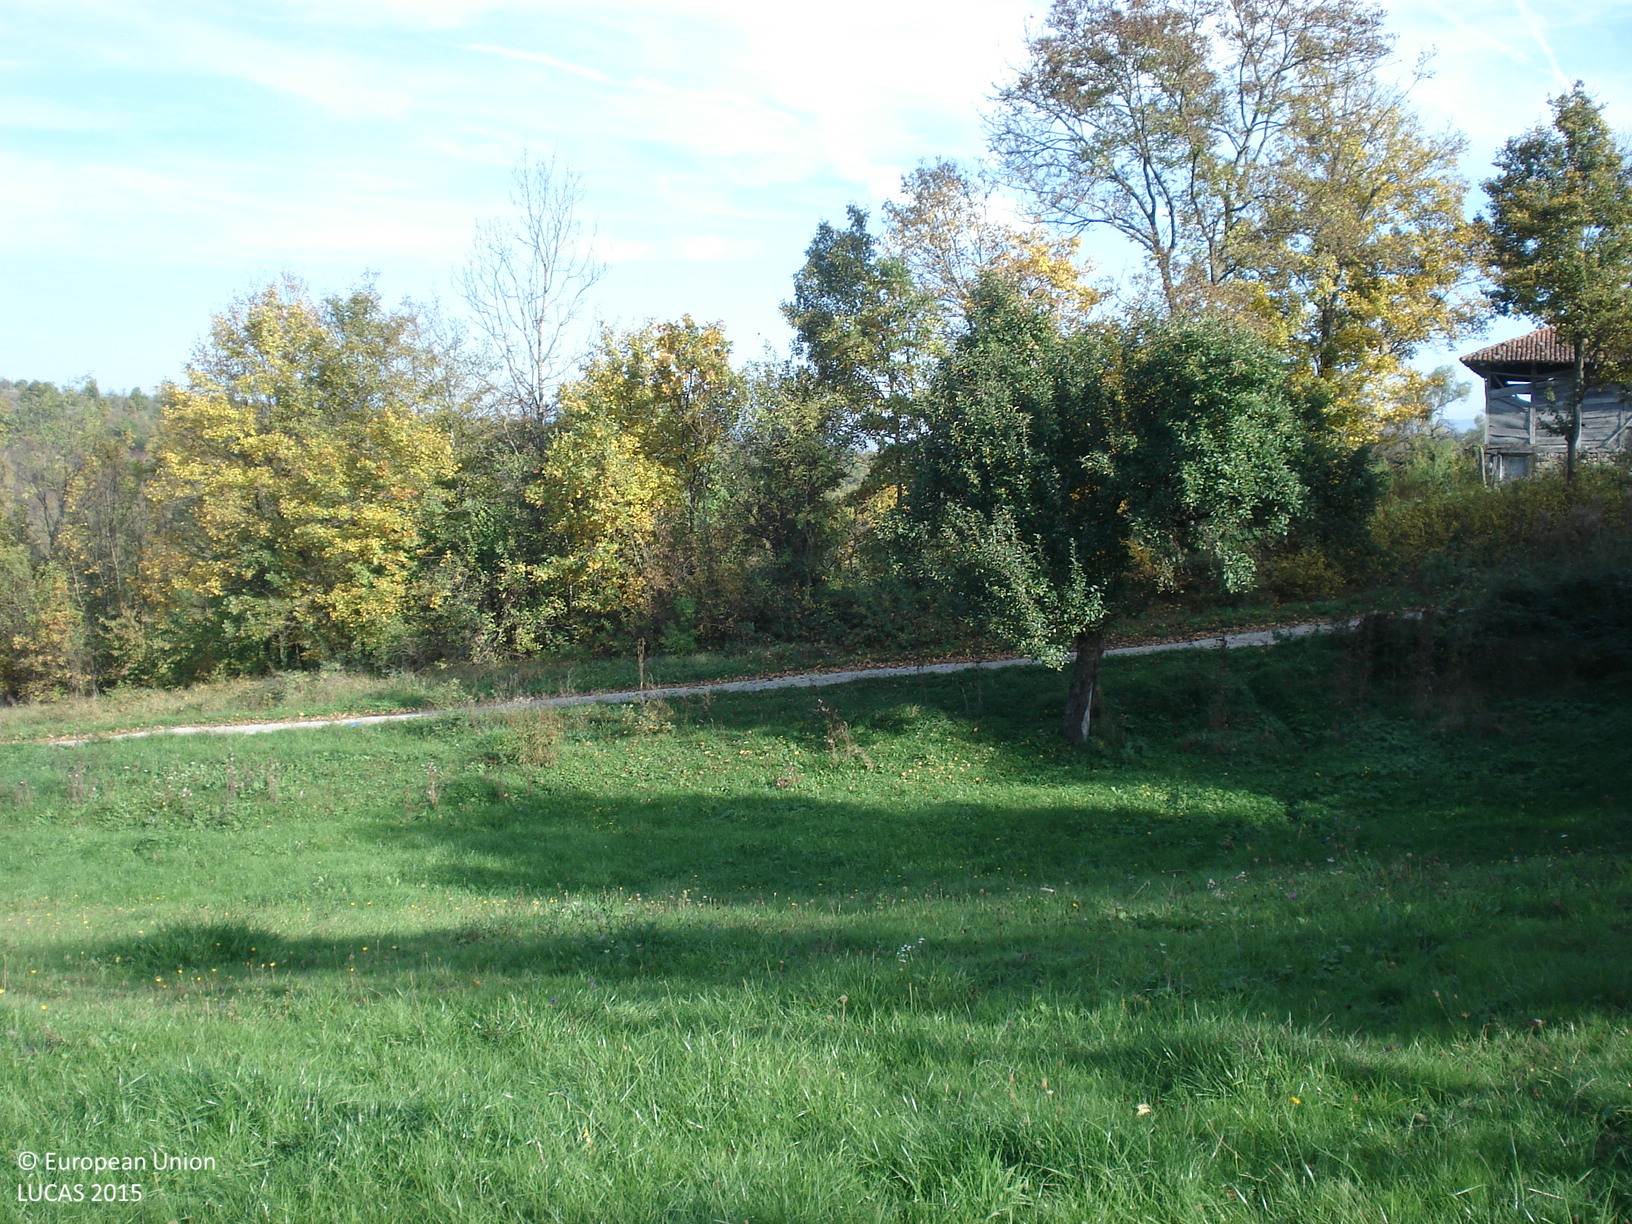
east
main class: Woodland
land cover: Broadleaved woodland
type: mesophytic deciduous forest
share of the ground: > 75 %
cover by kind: broadleaved forest trees 80 %, herbaceous plants 15 %, shrubs 5 %
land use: Semi-natural and natural areas not in use
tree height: < 5 m
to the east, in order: Broadleaved woodland; Paved roads, cycling and walking lanes; Broadleaved woodland
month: October
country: BG
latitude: 42.9006
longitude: 26.0947
